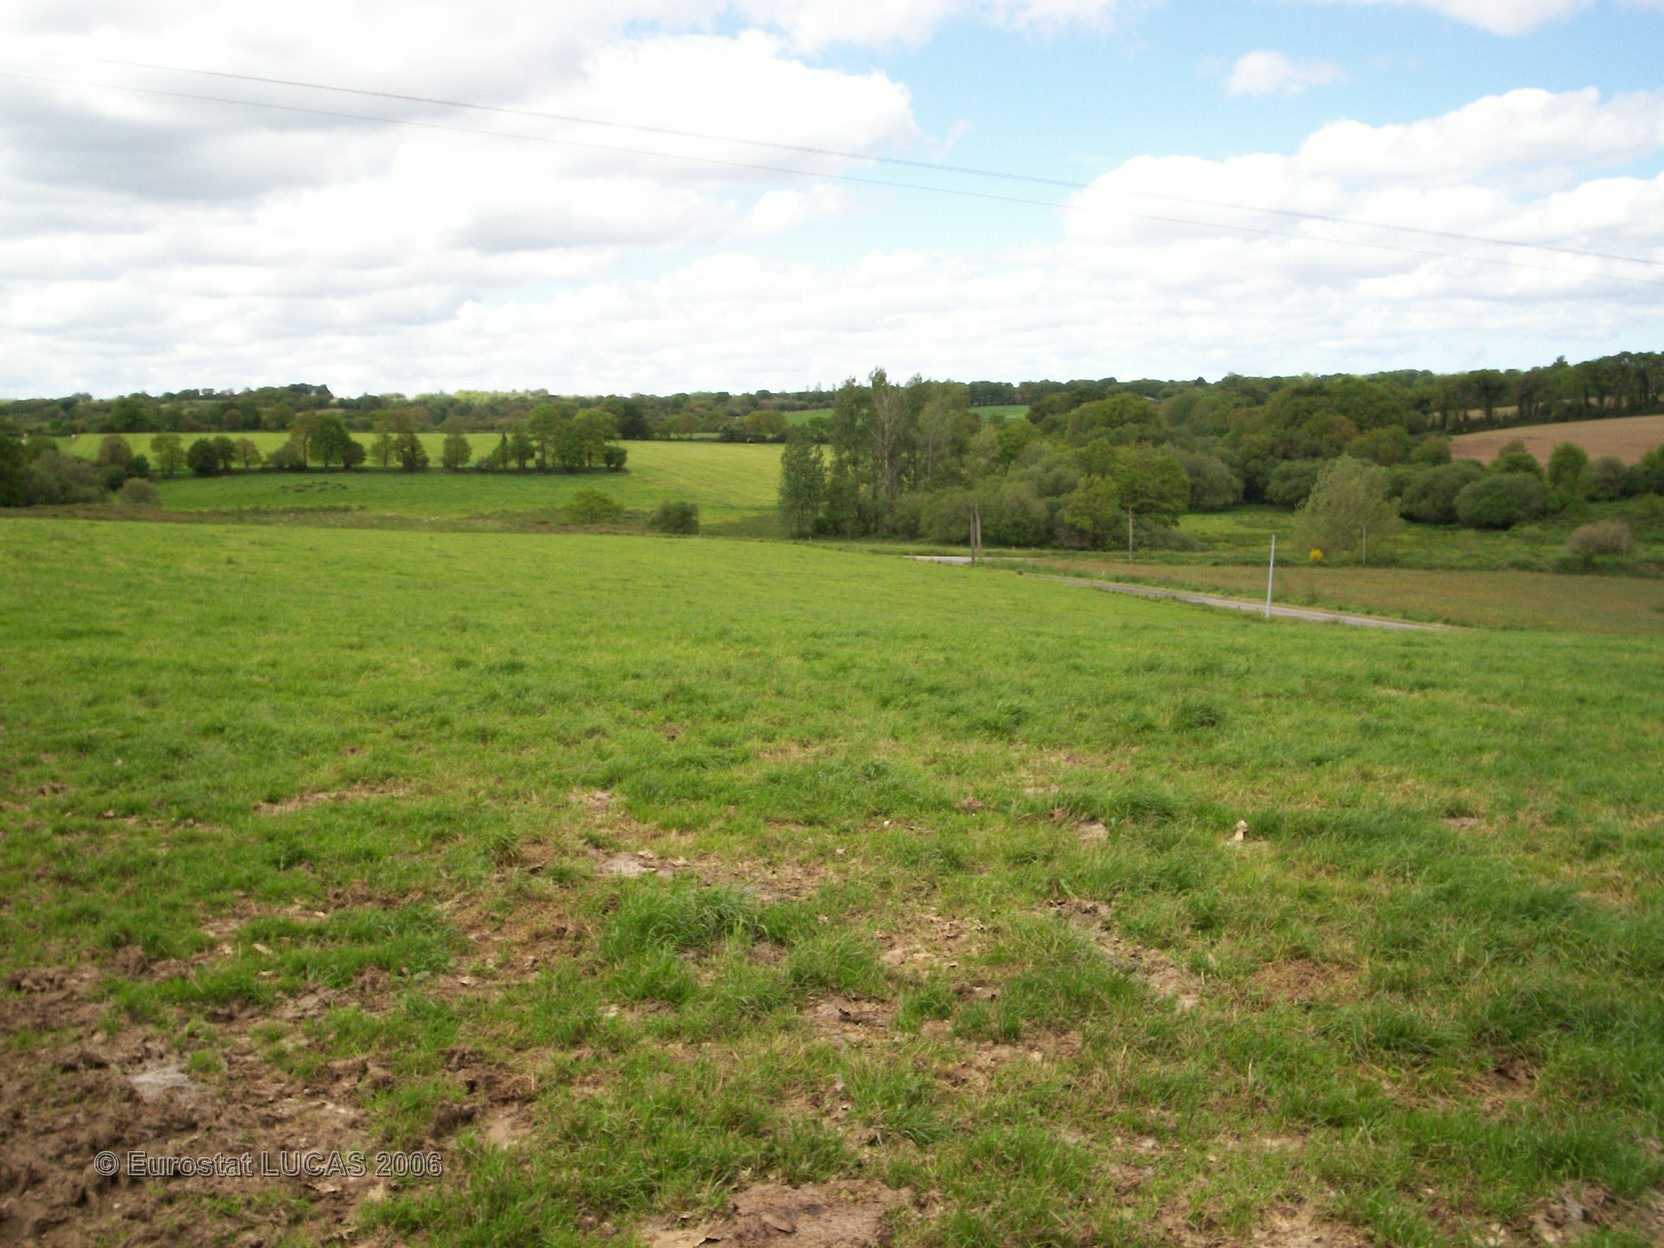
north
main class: Grassland
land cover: Grassland without tree/shrub cover
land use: Agriculture (excluding fallow land and kitchen gardens)
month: May
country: FR
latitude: 48.4011
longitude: -2.9687
